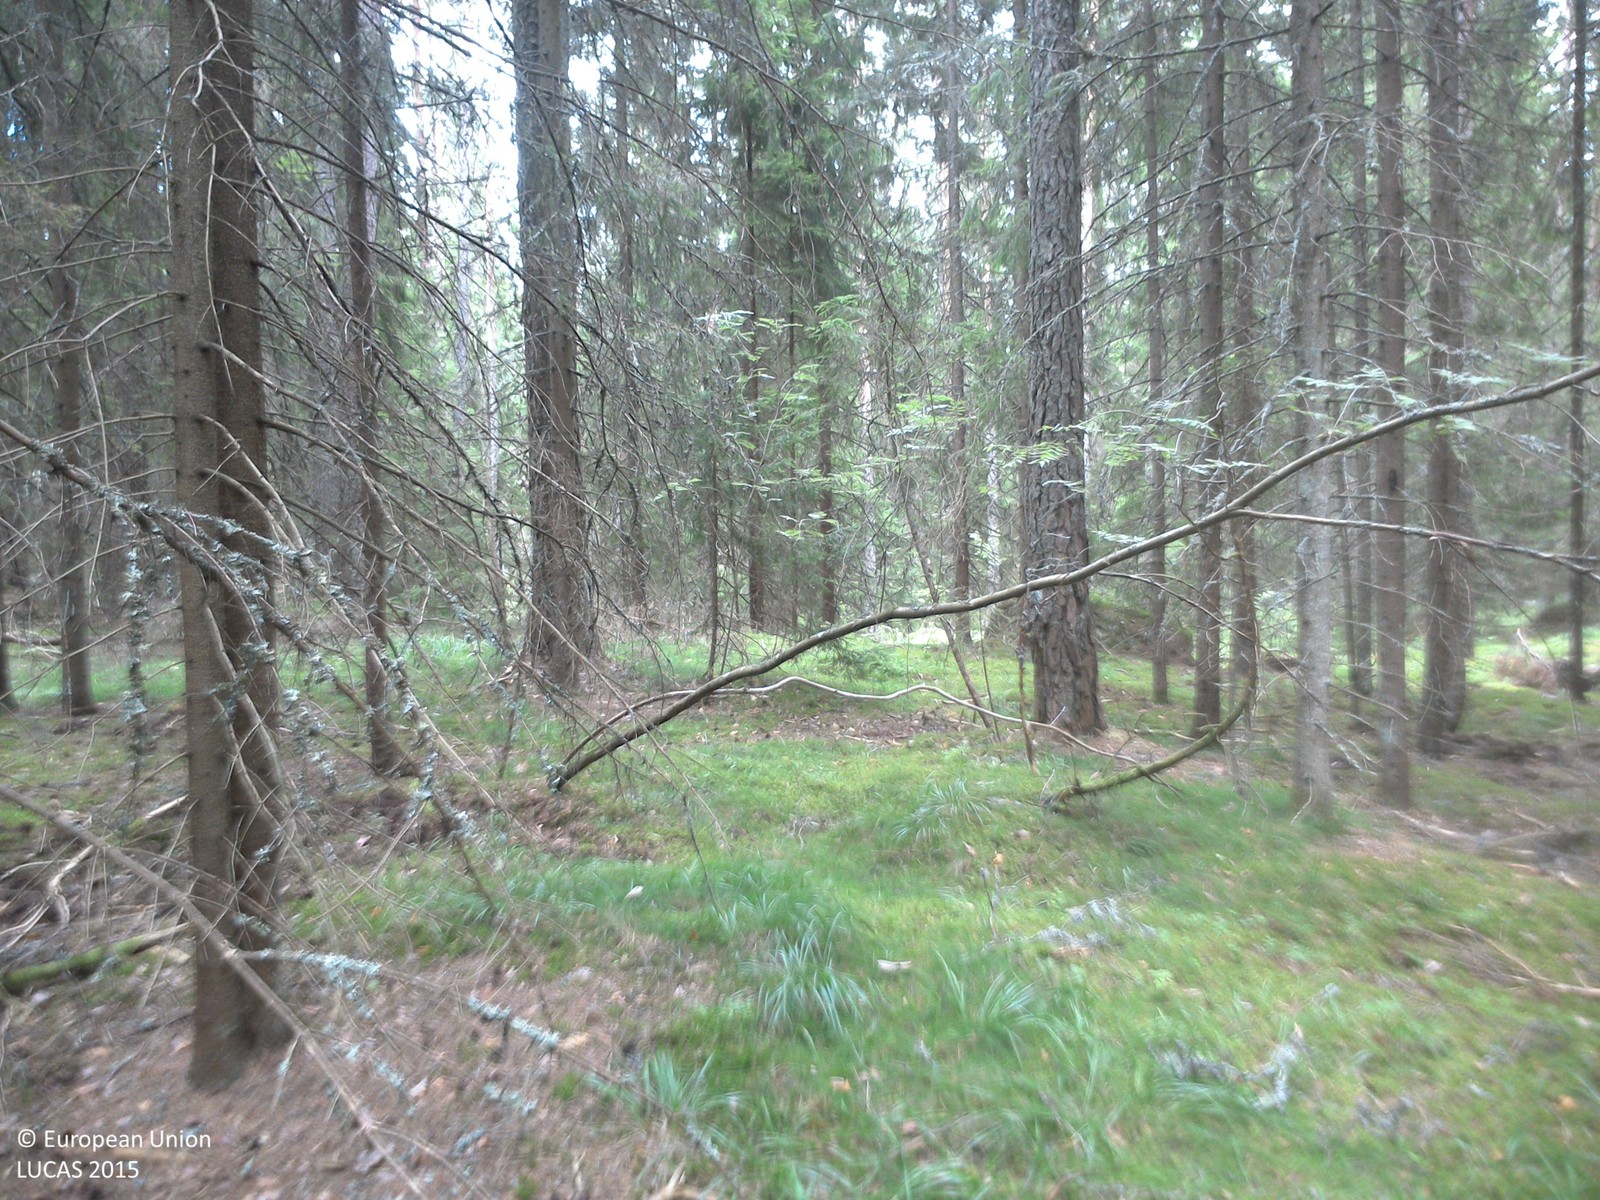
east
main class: Woodland
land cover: Spruce dominated coniferous woodland
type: boreal forest
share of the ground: 50 - 75 %
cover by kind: coniferous forest trees 60 %, herbaceous plants 20 %, lichens and mosses 20 %
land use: Forestry
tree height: > 5 m
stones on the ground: < 10 %
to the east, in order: Spruce dominated coniferous woodland; Paved roads, cycling and walking lanes; Electric lines; Spruce dominated coniferous woodland; Paved roads, cycling and walking lanes; Spruce dominated coniferous woodland; Grassland with sparse tree/shrub cover; Electric lines; Grassland with sparse tree/shrub cover; Pine dominated coniferous woodland; Spruce dominated coniferous woodland; Grassland without tree/shrub cover
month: August
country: SE
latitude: 57.9811
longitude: 15.4914
